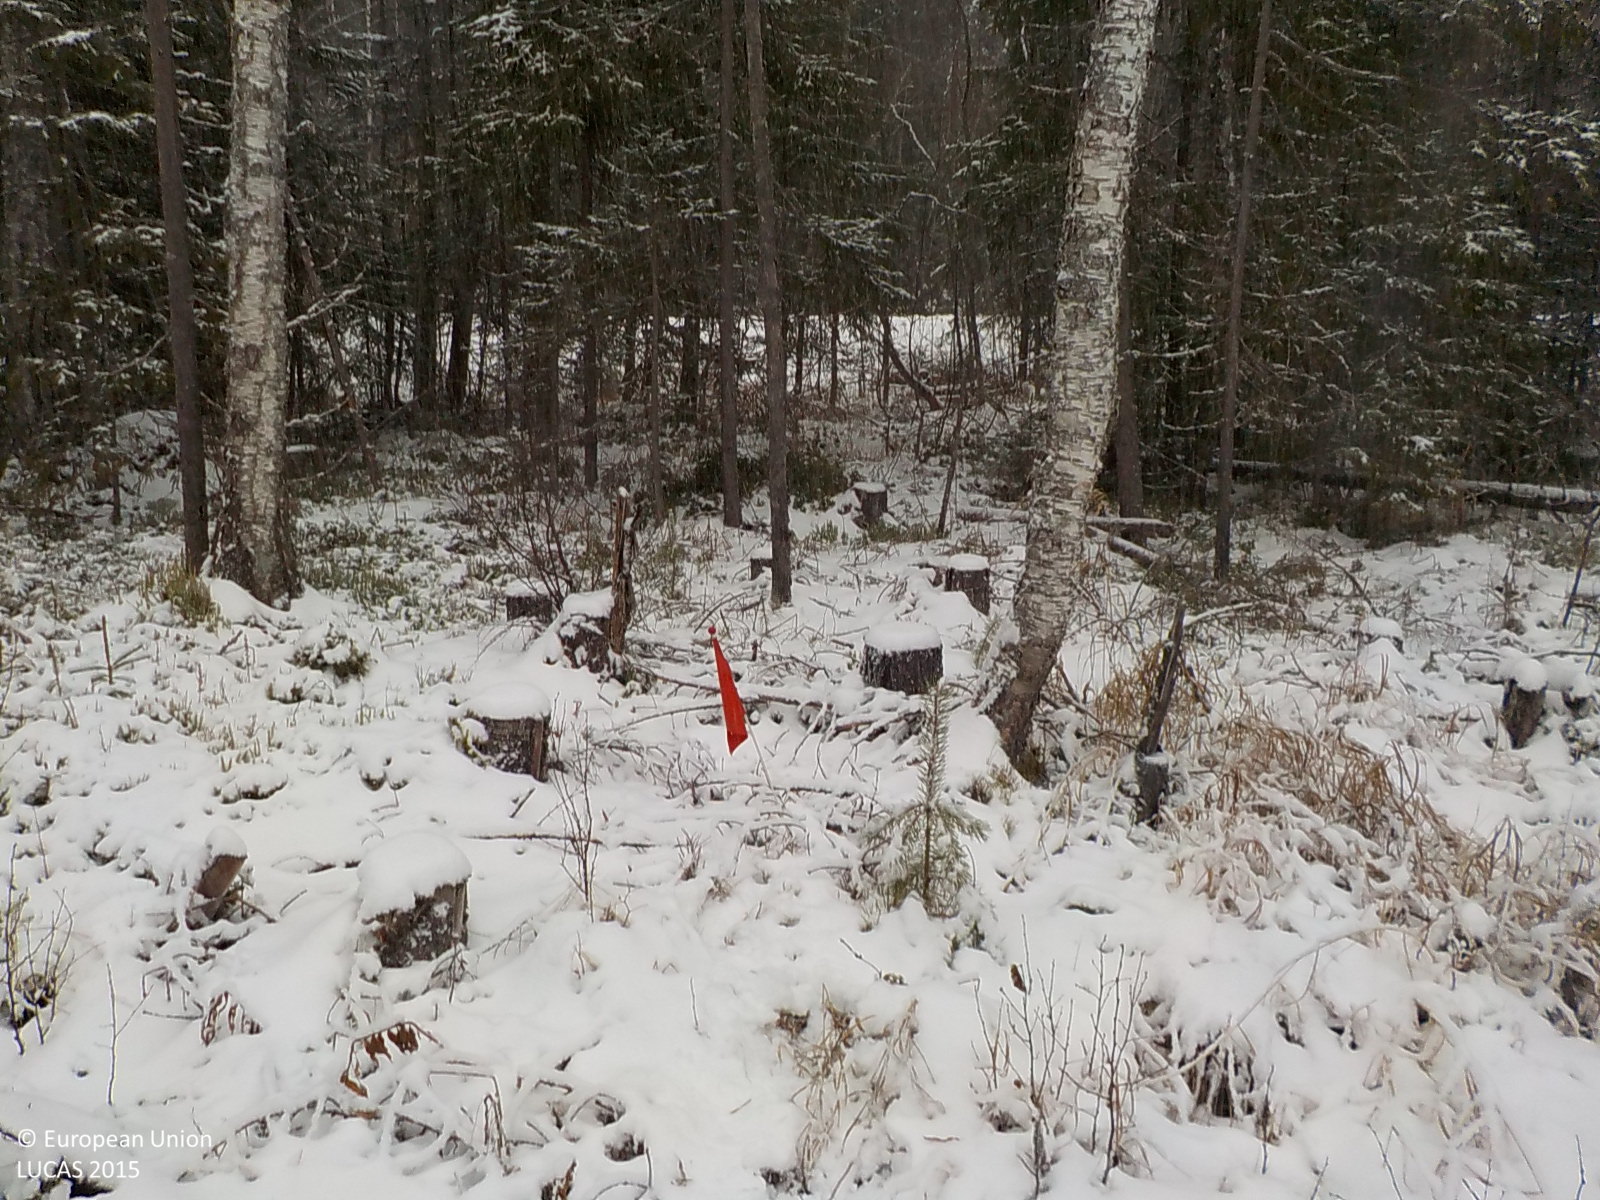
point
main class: Woodland
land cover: Other mixed woodland
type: boreal forest
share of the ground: 50 - 75 %
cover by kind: broadleaved forest trees 40 %, coniferous forest trees 30 %, herbaceous plants 30 %
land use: Forestry
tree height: > 5 m
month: December
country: SE
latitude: 63.3020
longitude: 16.9773
